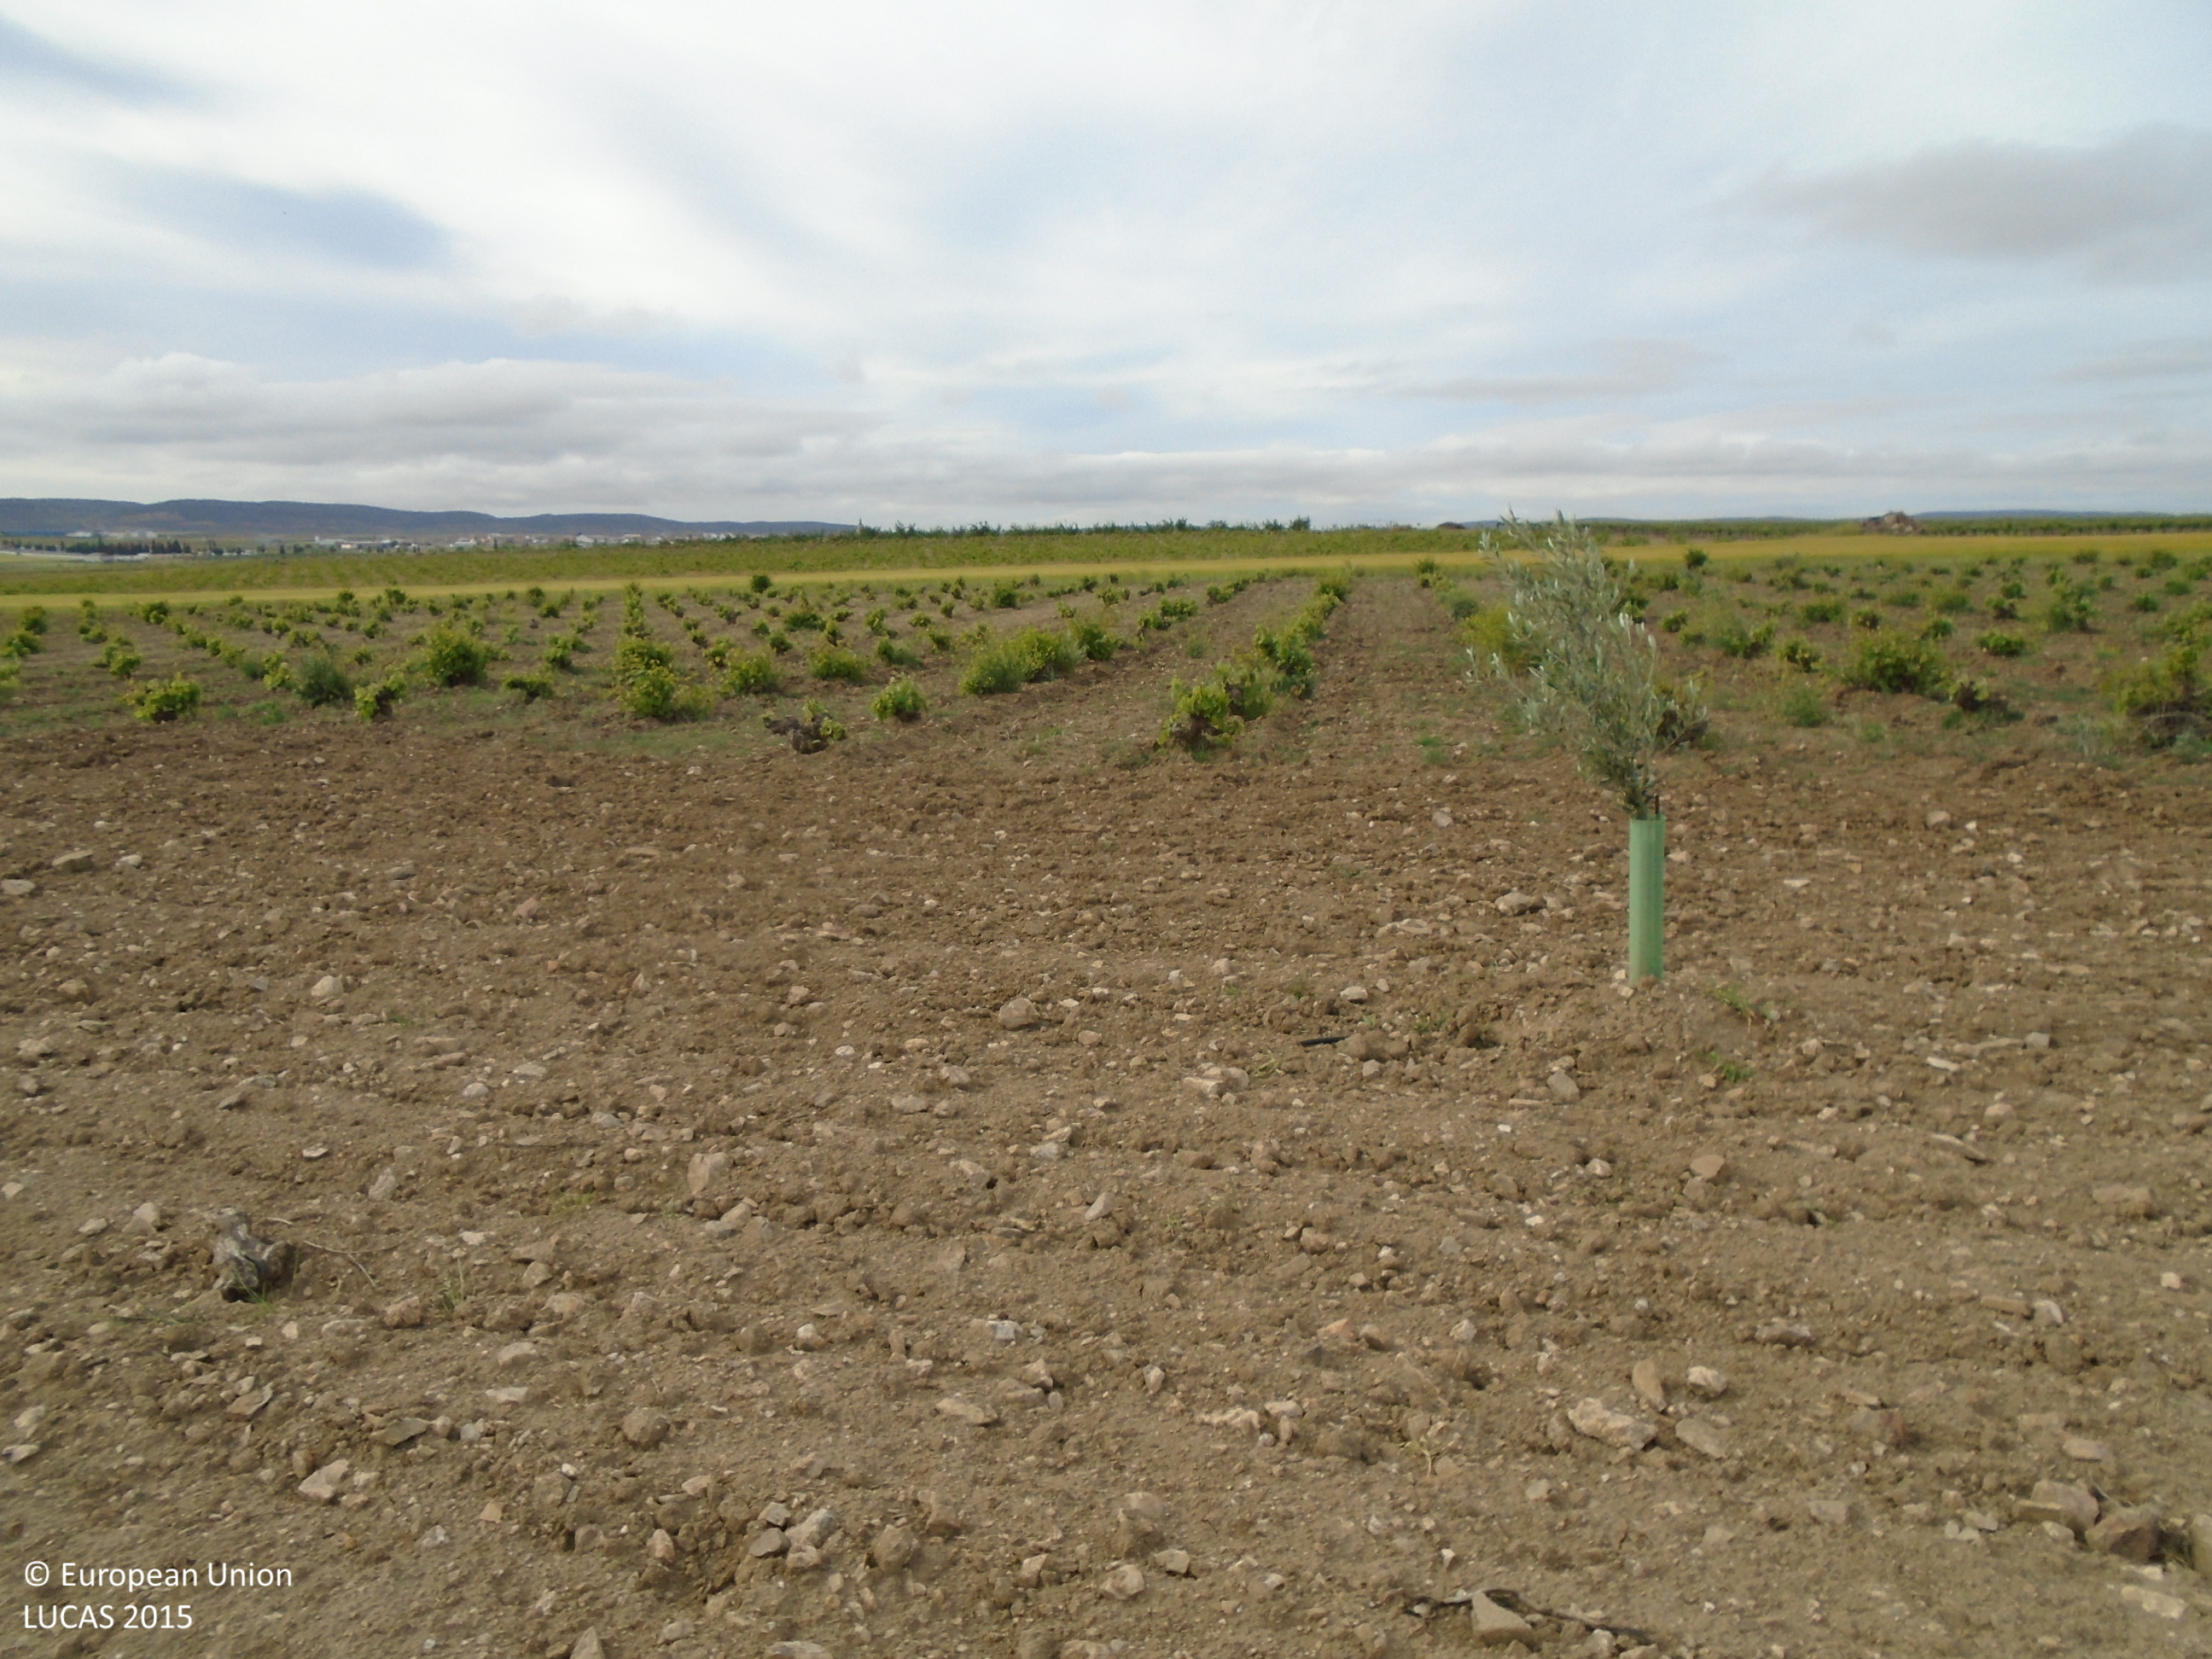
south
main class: Cropland
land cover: Olive groves
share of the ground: < 10 %
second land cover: Other bare soil
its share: > 75 %
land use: Agriculture (excluding fallow land and kitchen gardens)
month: May
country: ES
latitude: 39.7112
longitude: -3.7813
